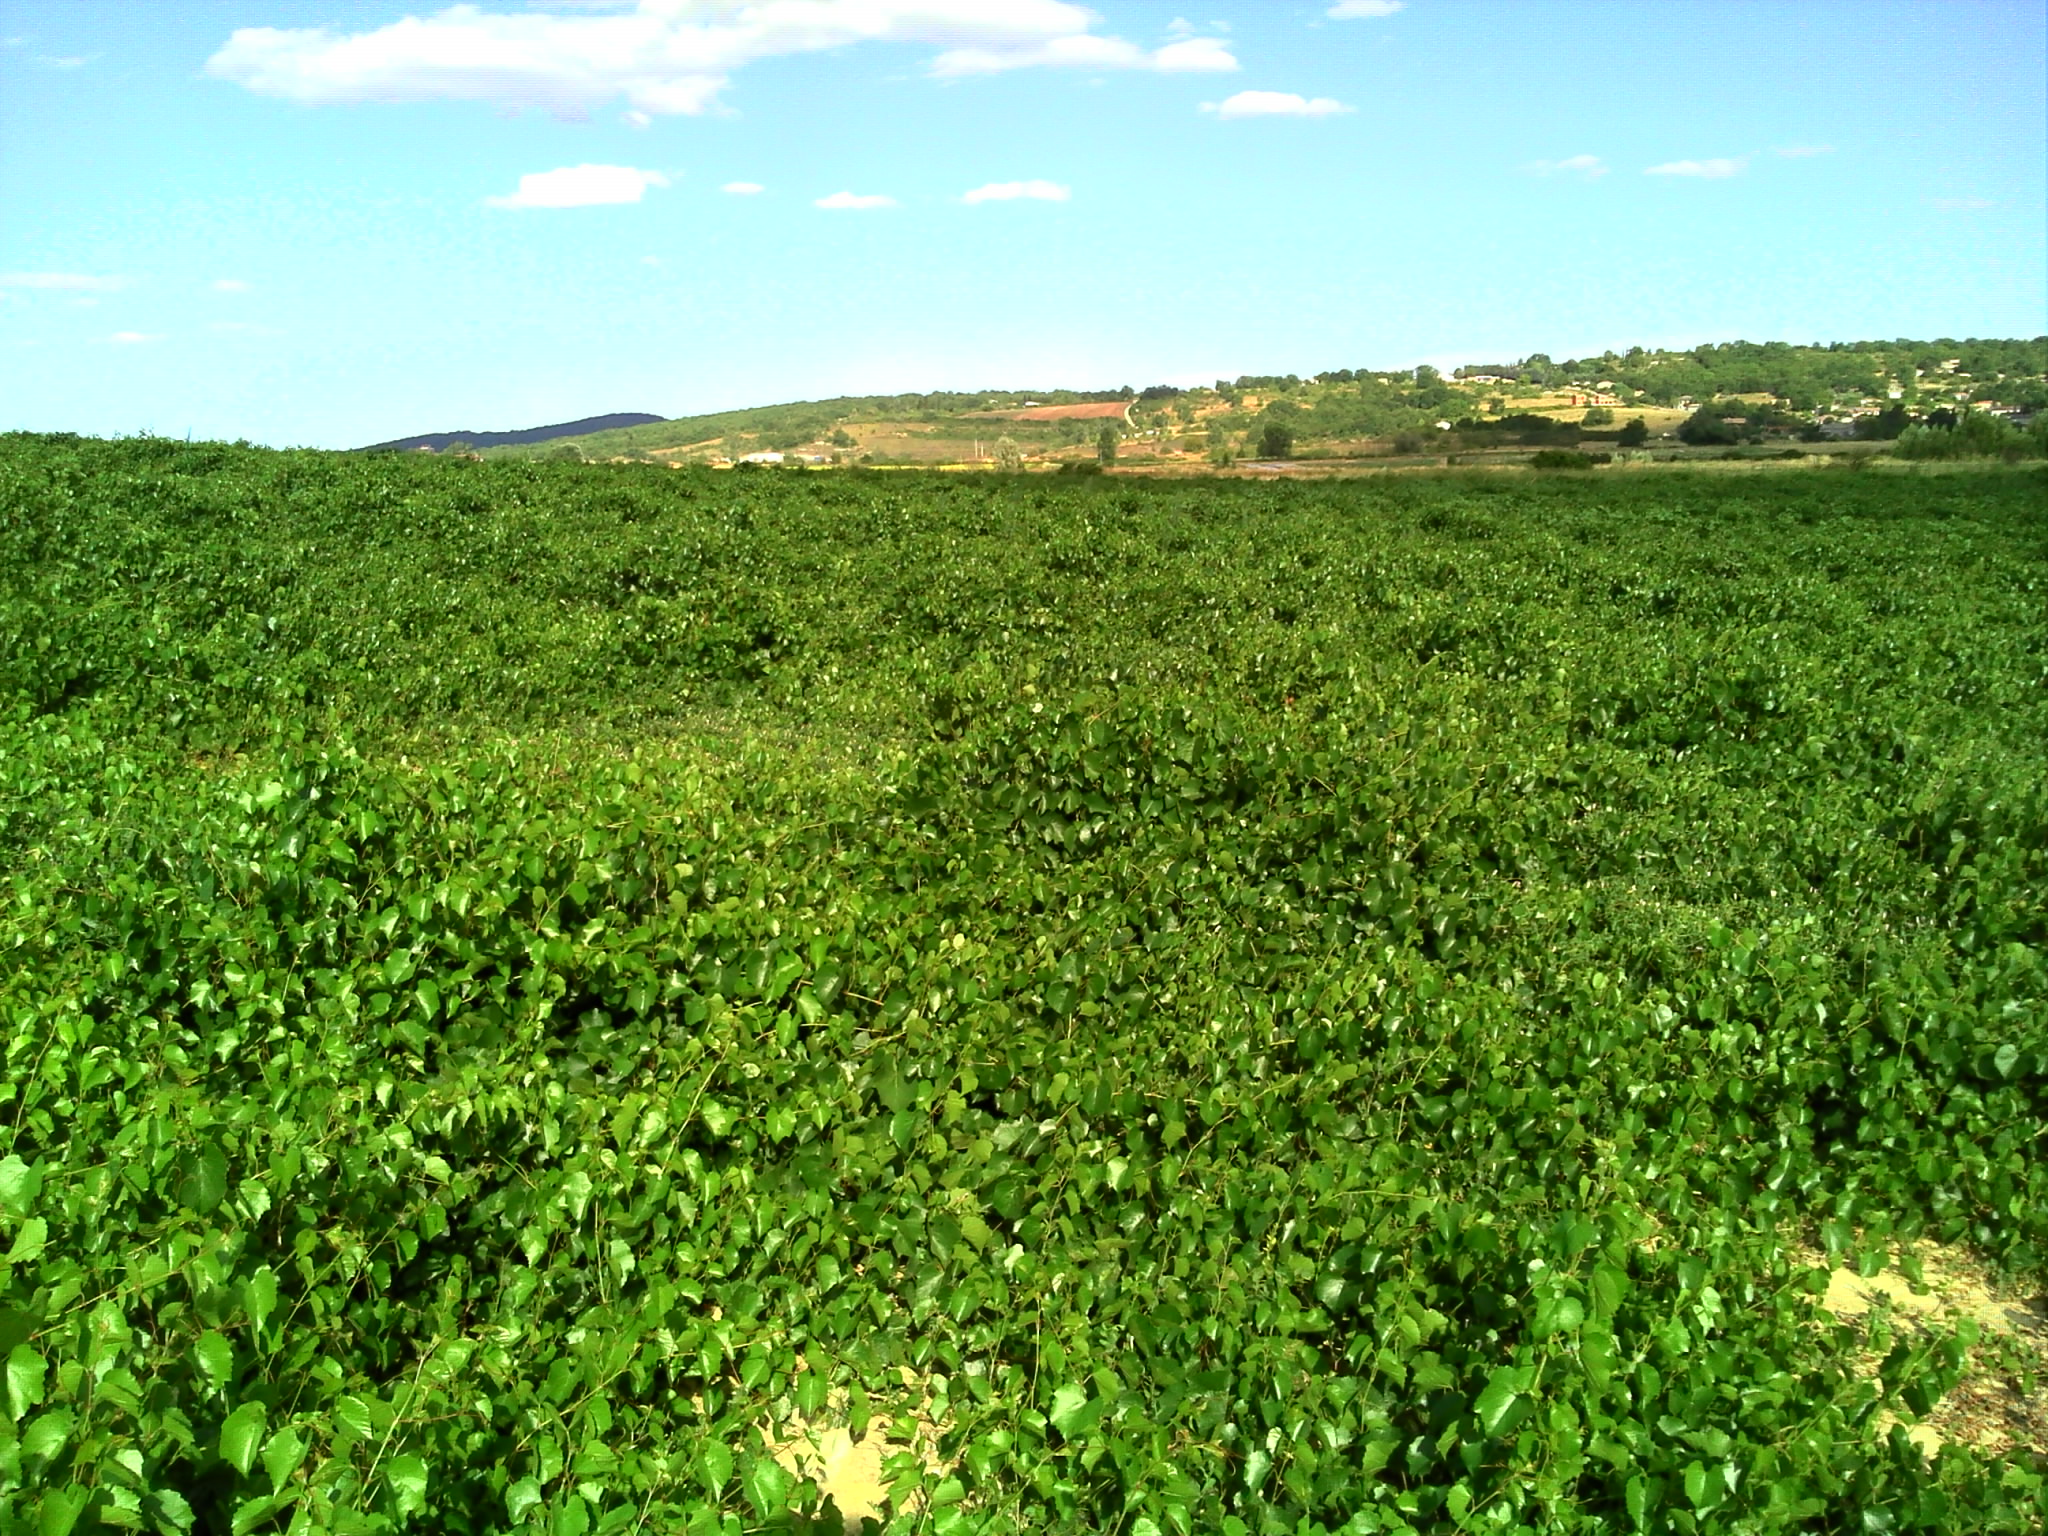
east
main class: Cropland
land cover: Vineyards
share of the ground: > 75 %
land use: Abandoned areas
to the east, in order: Vineyards; Grass margins; Paved roads, cycling and walking lanes; Ditches and canals; Abandoned hedges; Durum wheat
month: July
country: FR
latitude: 44.2652
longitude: 4.2825
